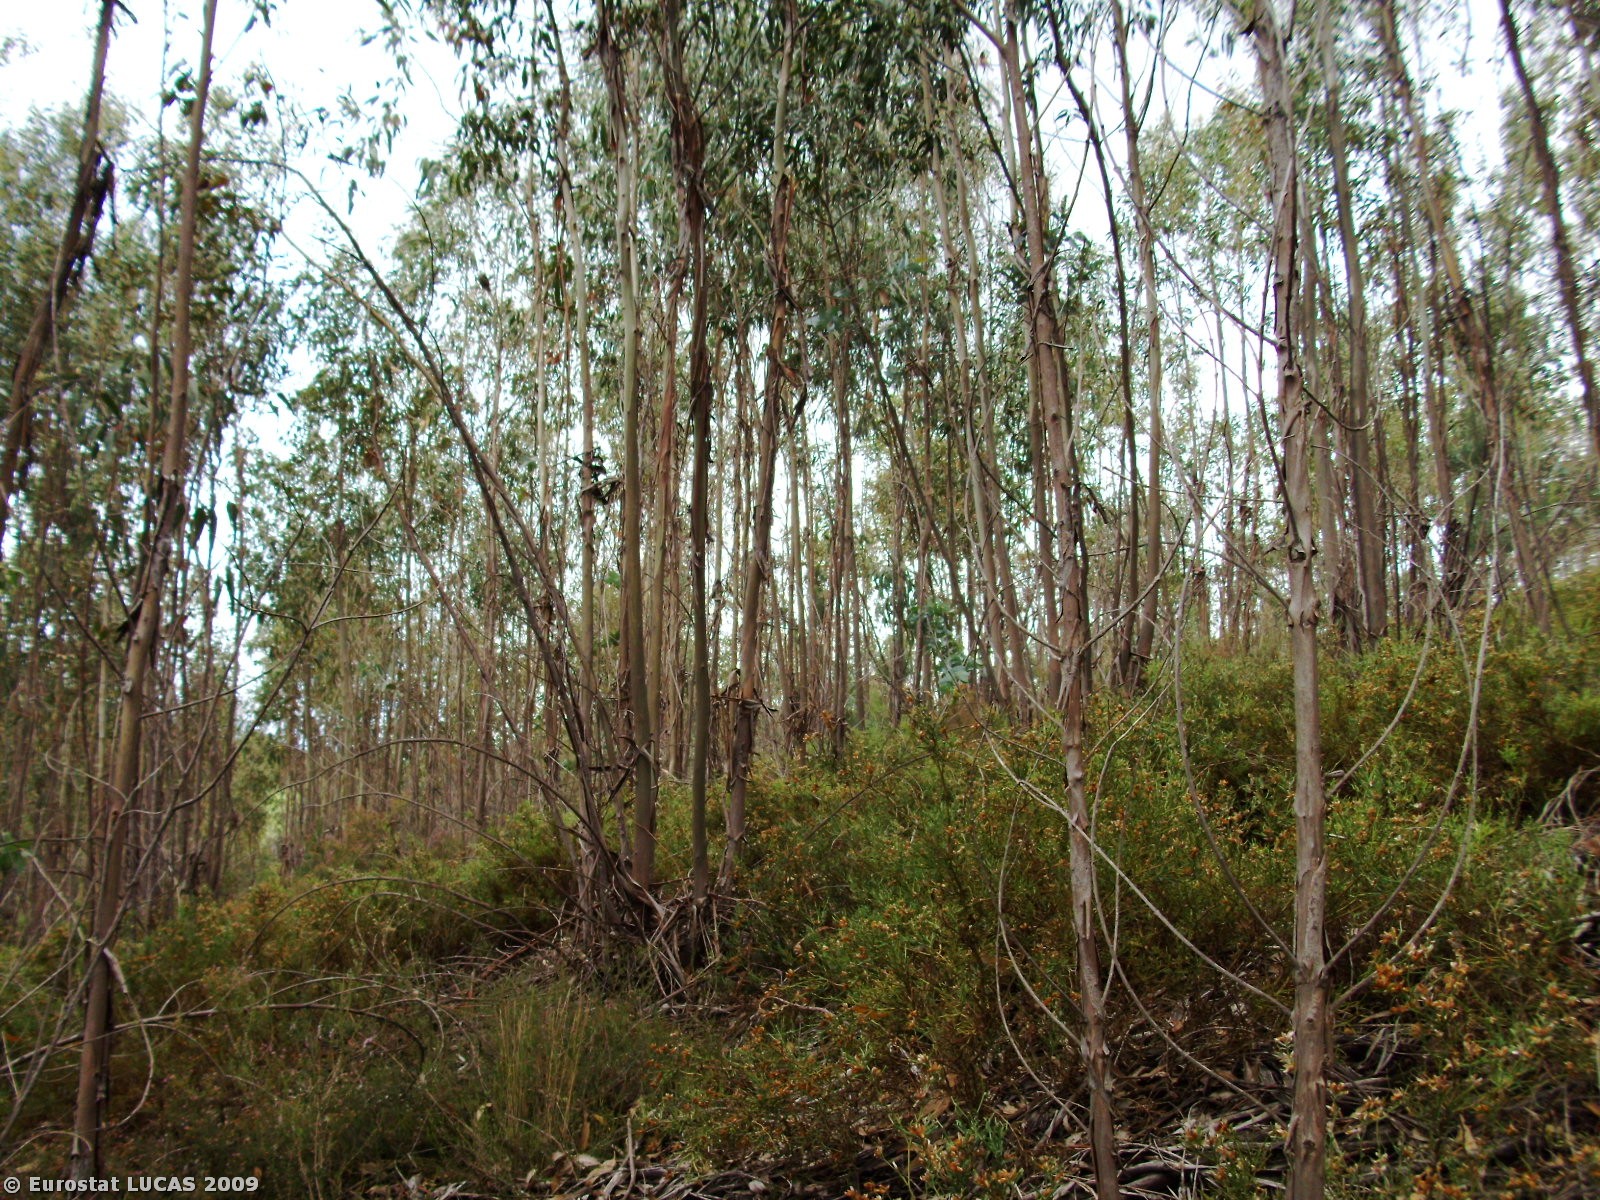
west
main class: Woodland
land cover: Broadleaved woodland
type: plantations and self-sown exotic forest
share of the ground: > 75 %
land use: Forestry
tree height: > 5 m
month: June
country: PT
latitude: 39.9663
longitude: -8.2322
